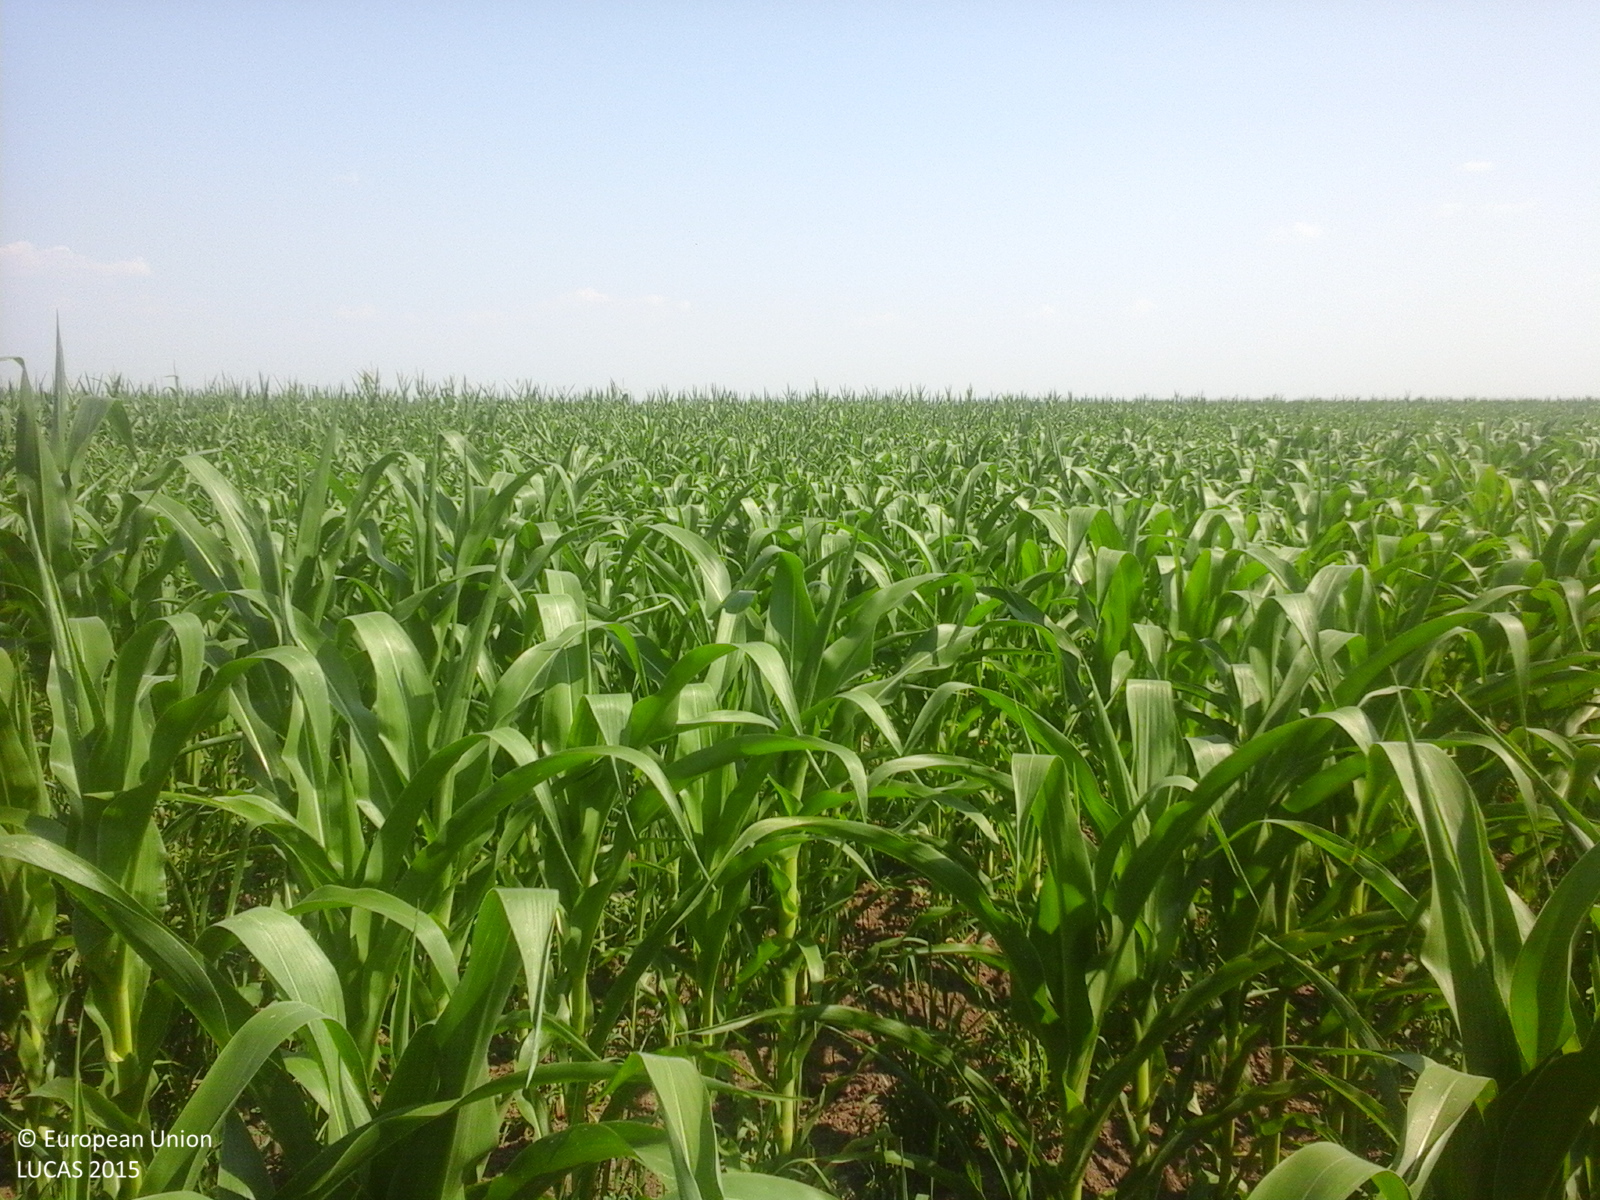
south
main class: Cropland
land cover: Maize
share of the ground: > 75 %
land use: Agriculture (excluding fallow land and kitchen gardens)
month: July
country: RO
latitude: 44.5787
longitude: 24.8257
